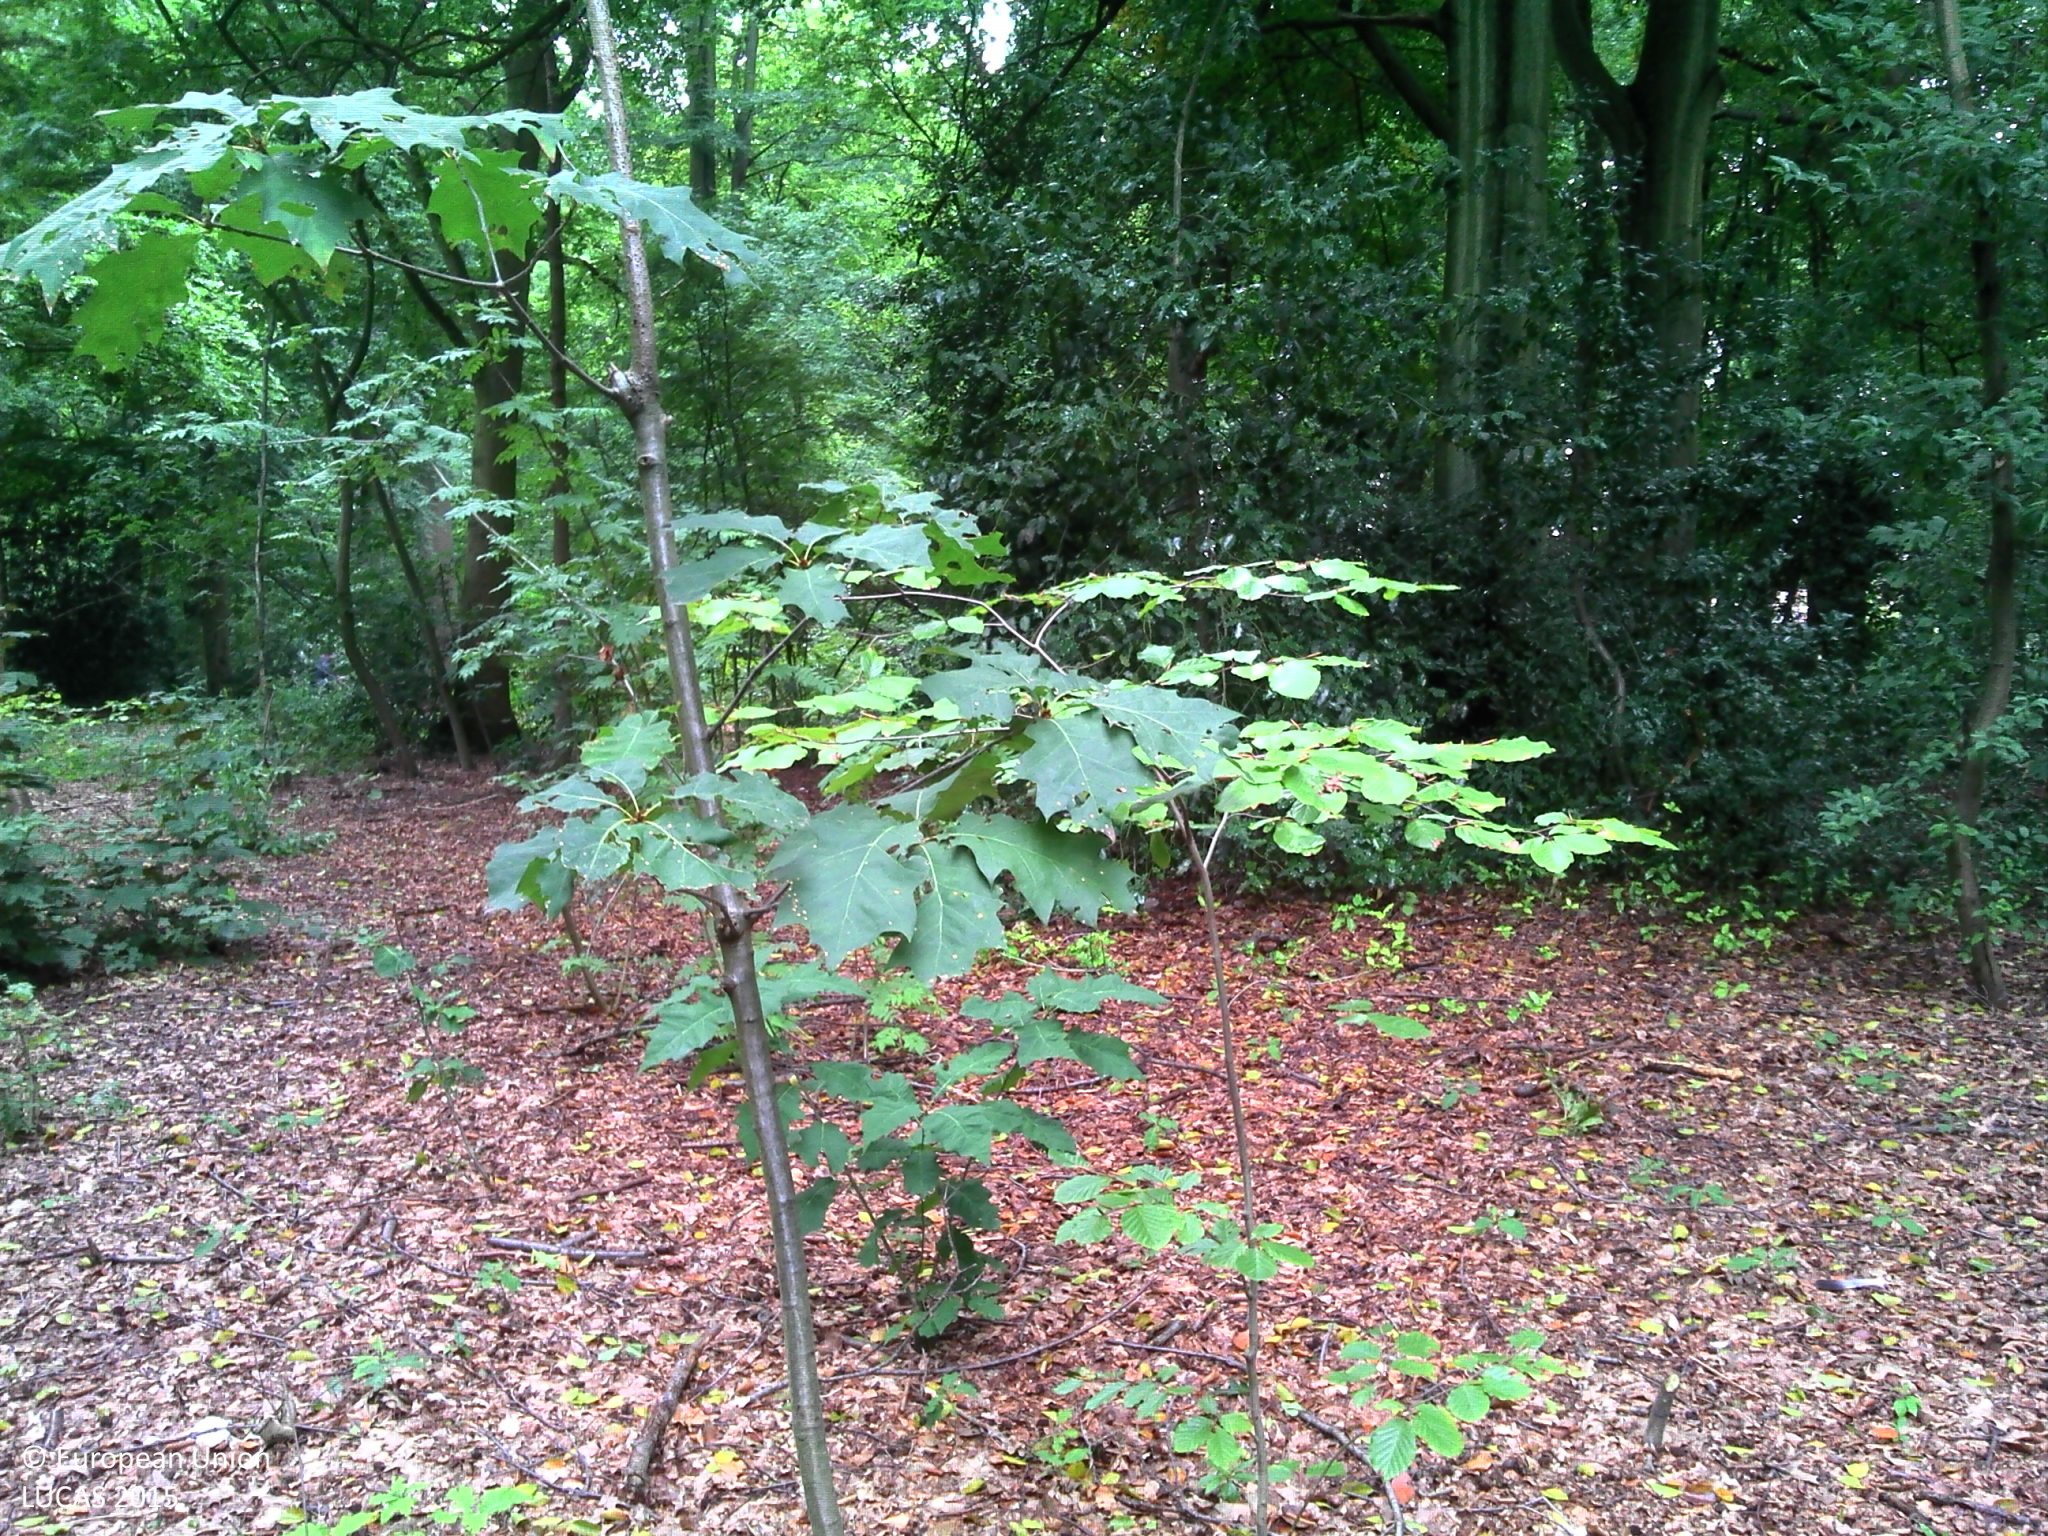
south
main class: Woodland
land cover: Broadleaved woodland
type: beech forest
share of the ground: 50 - 75 %
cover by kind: broadleaved forest trees 60 %, shrubs 20 %, unconsolidated bare surface 20 %
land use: Amenities, museums, leisure
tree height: > 5 m
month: September
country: BE
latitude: 51.1822
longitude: 4.4018
